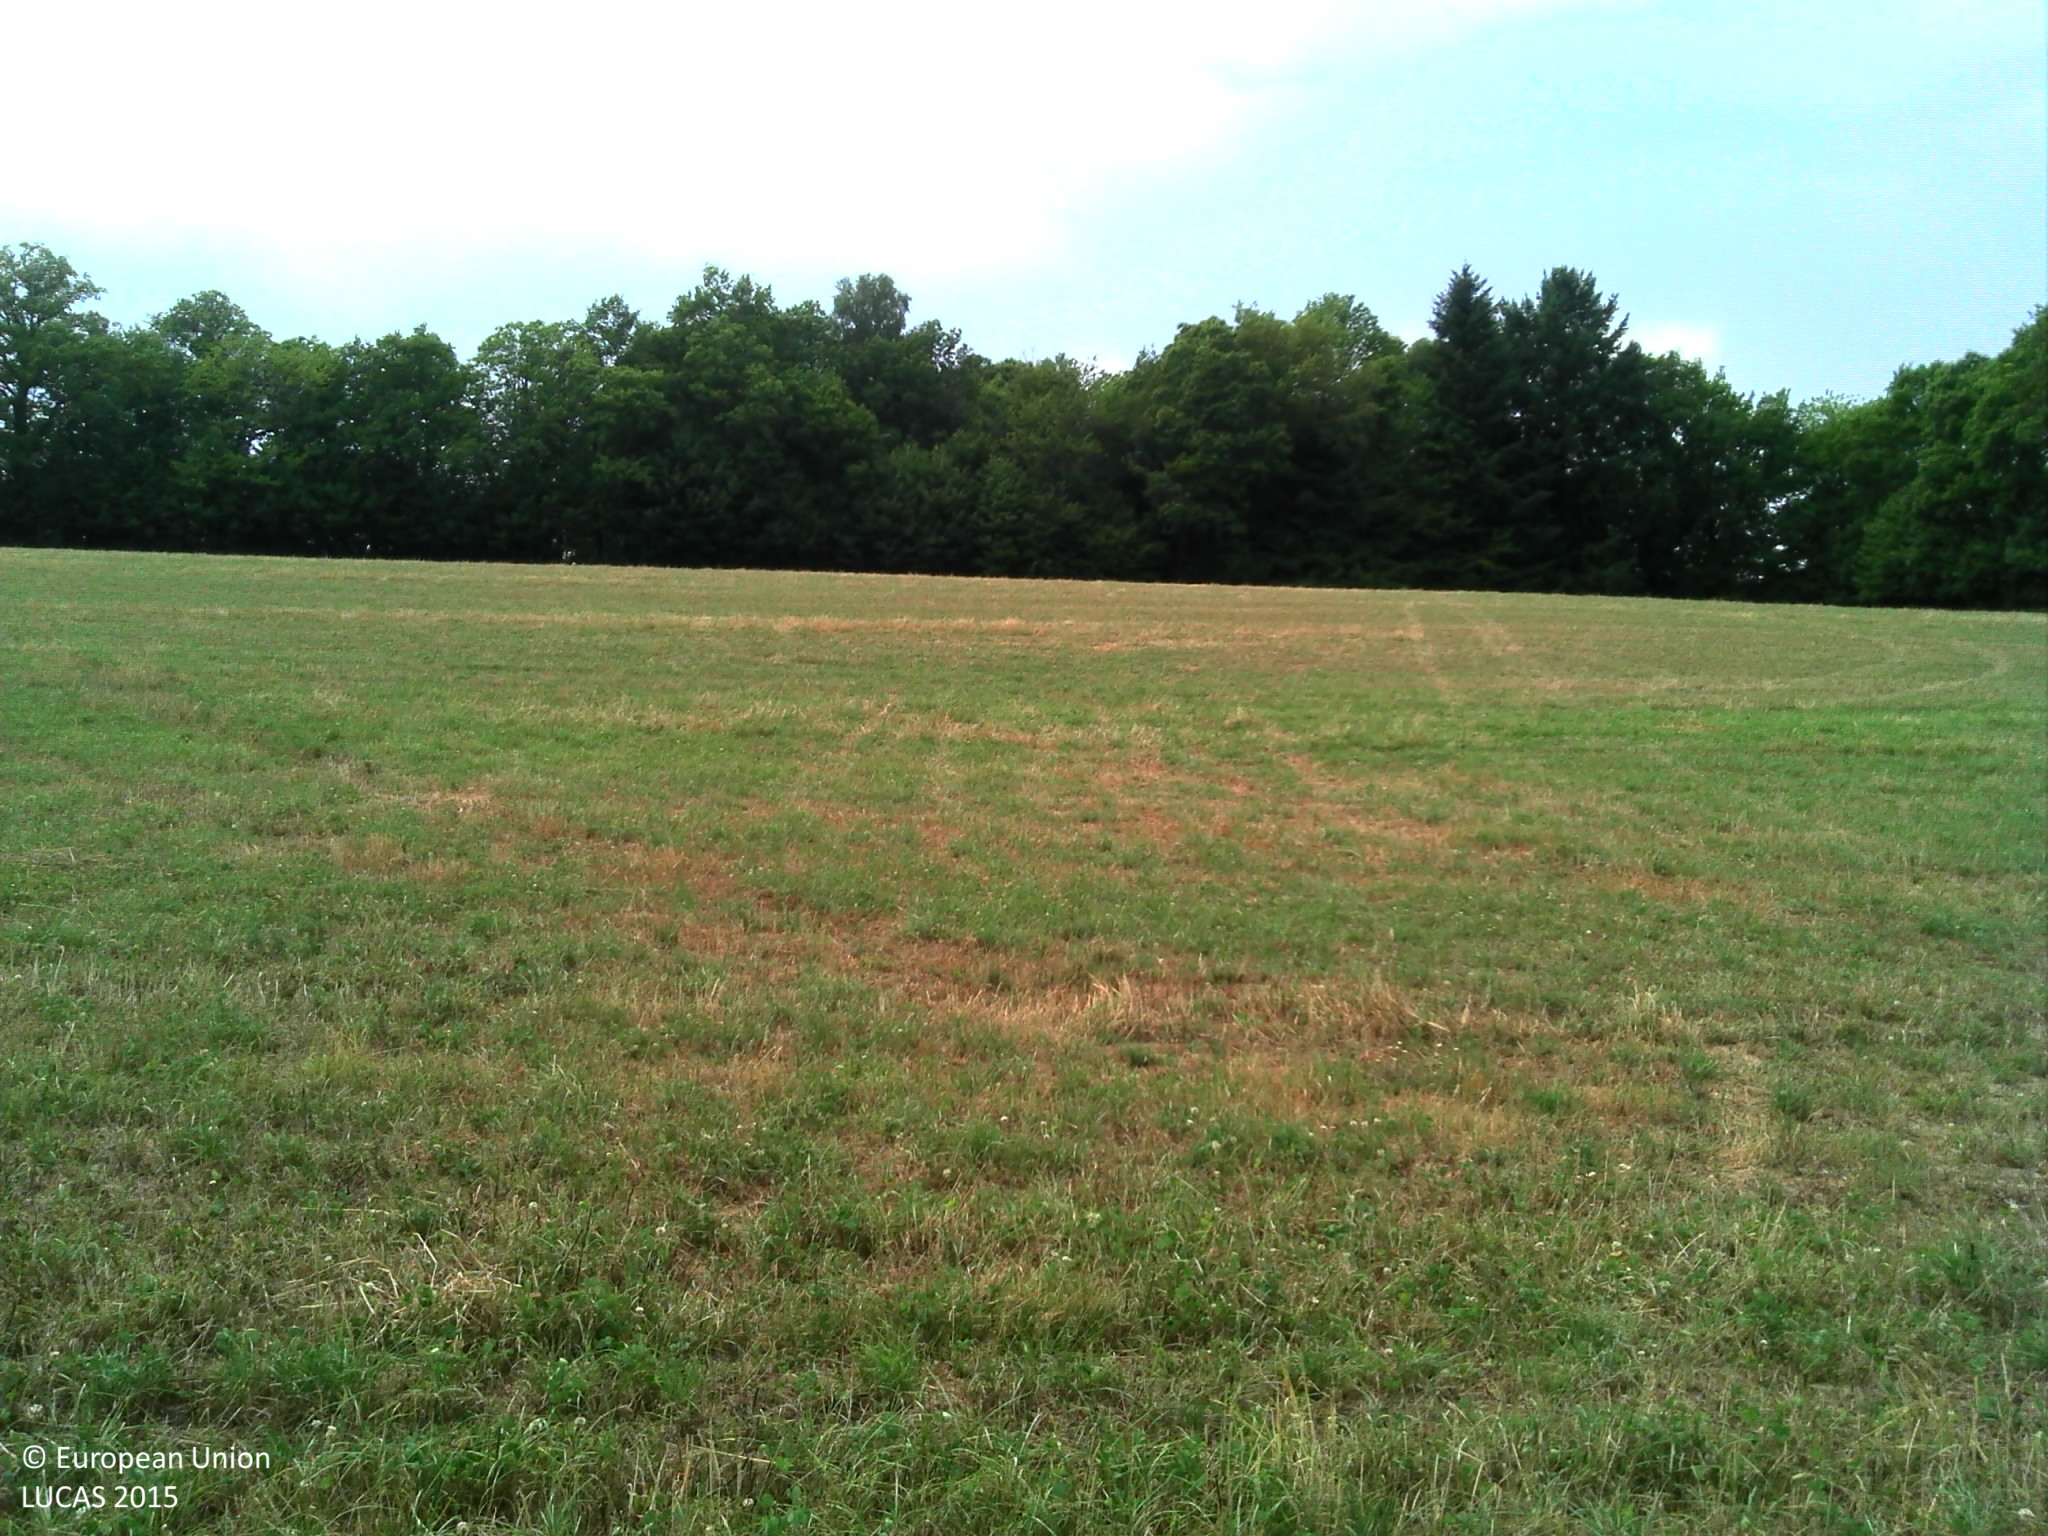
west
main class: Grassland
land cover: Grassland without tree/shrub cover
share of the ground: > 75 %
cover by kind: herbaceous plants 100 %
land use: Agriculture (excluding fallow land and kitchen gardens)
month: July
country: FR
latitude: 45.6647
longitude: 1.0182
